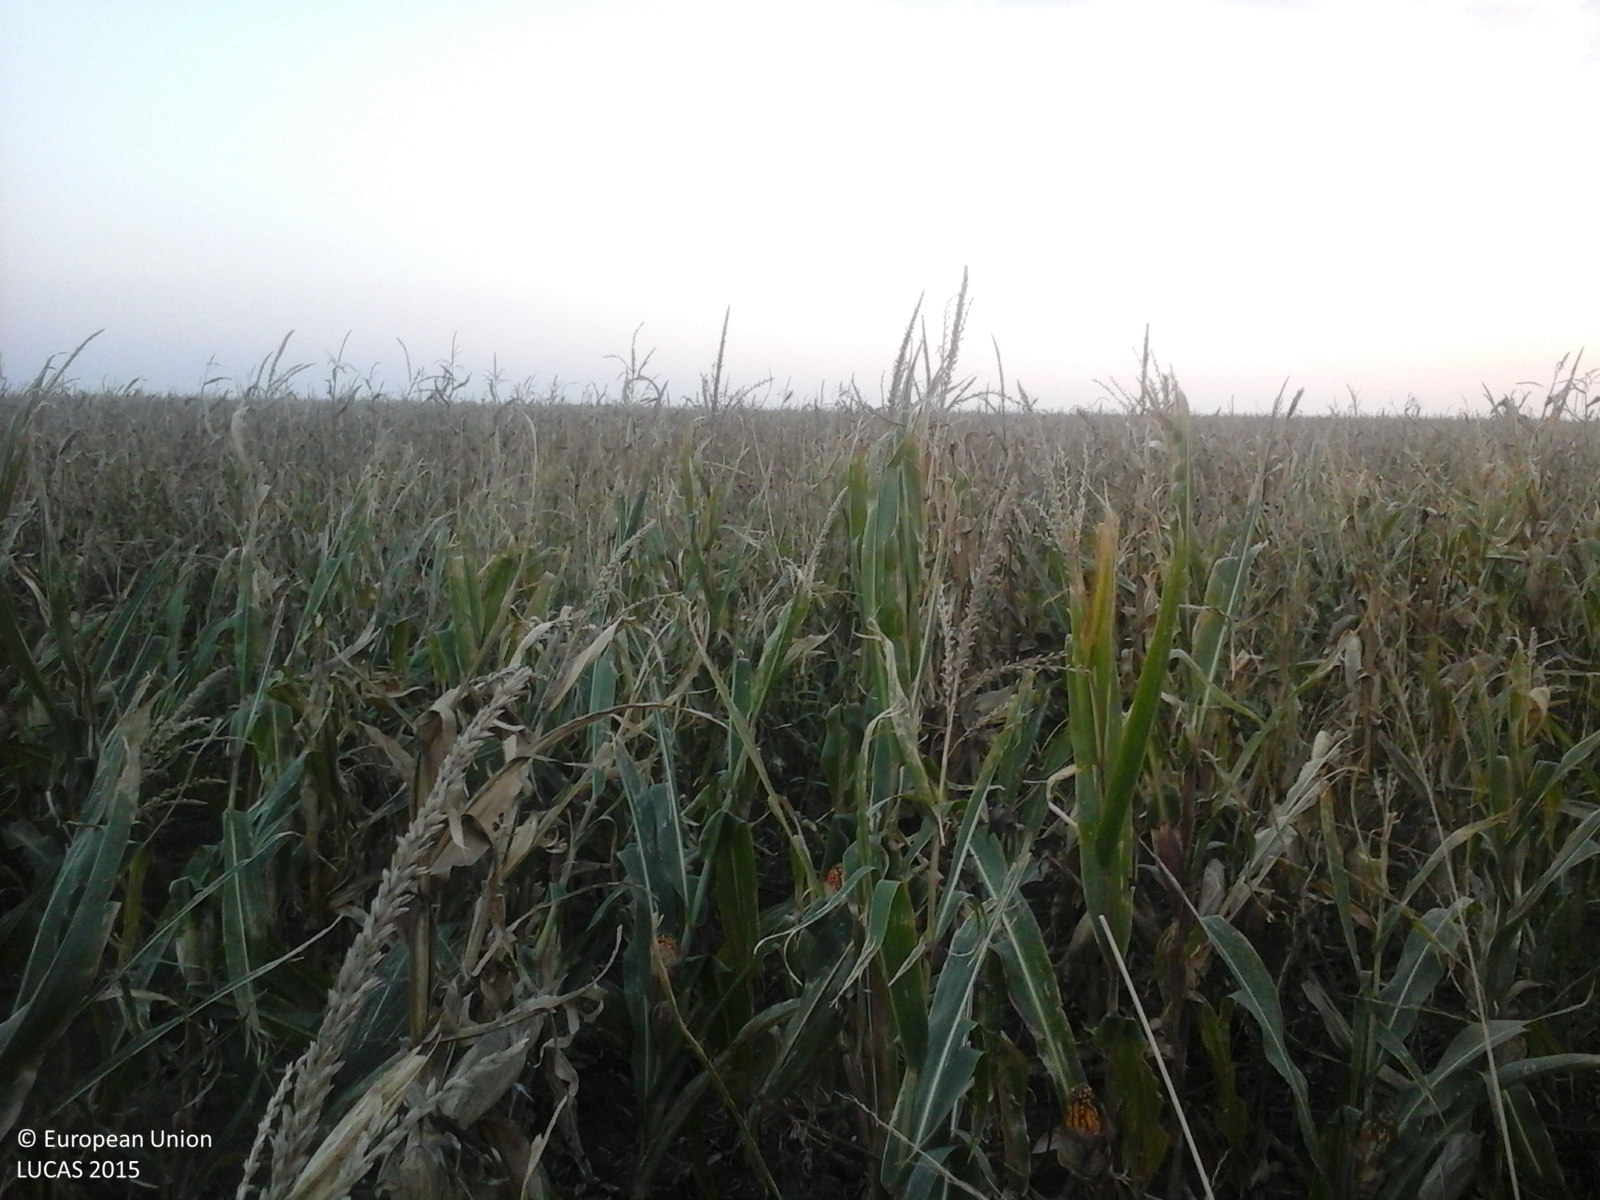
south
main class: Cropland
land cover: Maize
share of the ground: > 75 %
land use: Agriculture (excluding fallow land and kitchen gardens)
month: October
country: RO
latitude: 45.2542
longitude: 26.9947
